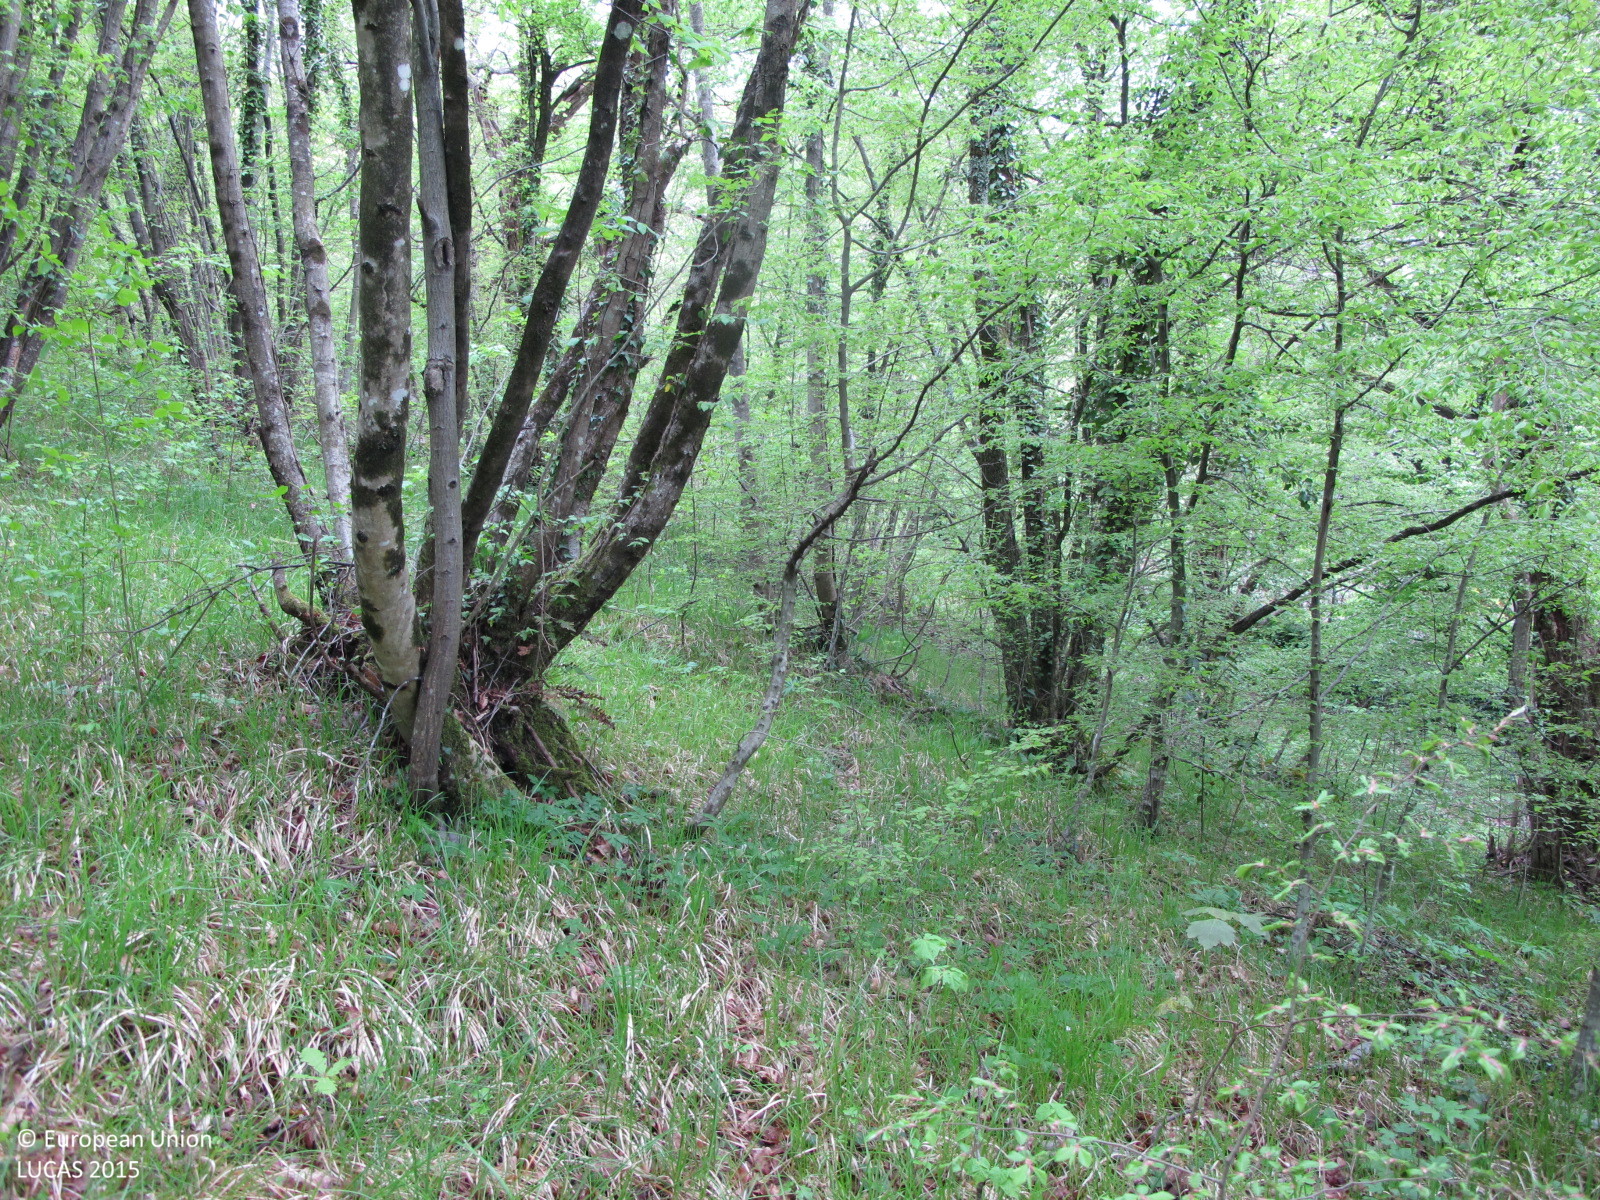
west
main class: Woodland
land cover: Broadleaved woodland
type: thermophilous deciduous forest
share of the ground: > 75 %
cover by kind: broadleaved forest trees 70 %, herbaceous plants 15 %, shrubs 5 %, lichens and mosses 5 %
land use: Semi-natural and natural areas not in use
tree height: > 5 m
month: April
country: HR
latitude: 45.3628
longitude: 14.2974
